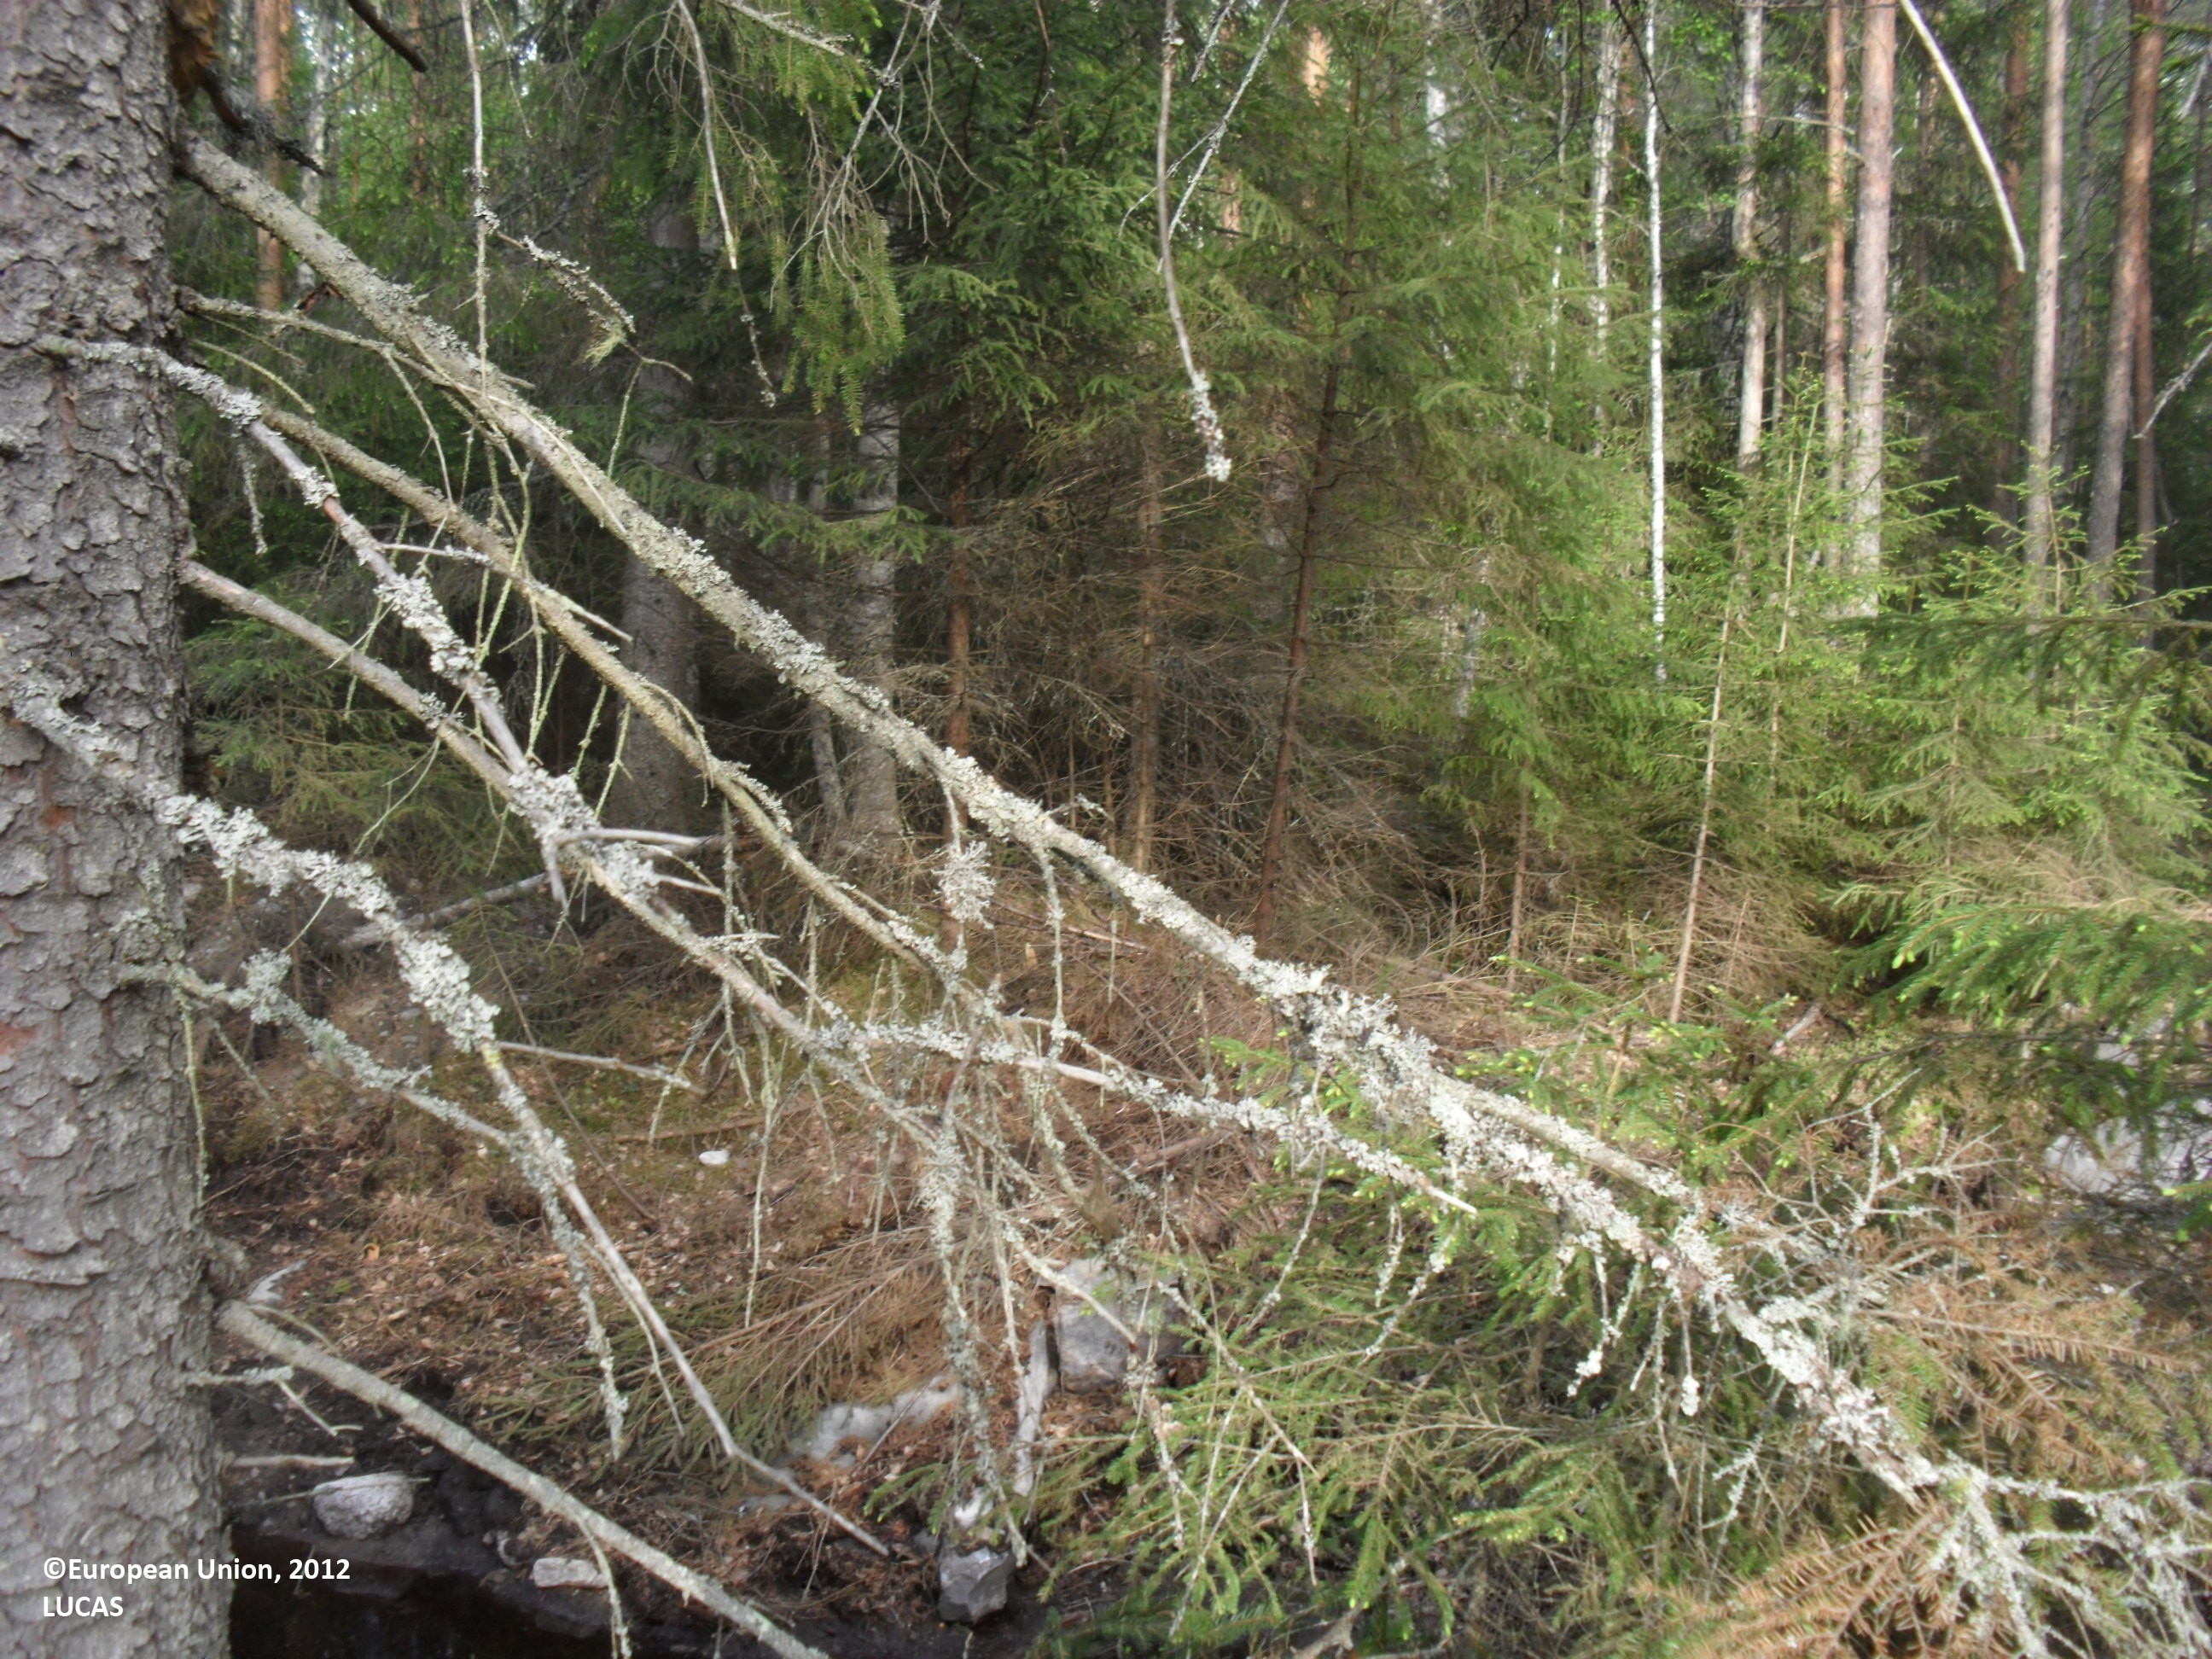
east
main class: Woodland
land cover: Other coniferous woodland
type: boreal forest
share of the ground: 25 - 50 %
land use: Forestry
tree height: > 5 m
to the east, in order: Other coniferous woodland; Other mixed woodland; Ditches and canals; Other mixed woodland; Ditches and canals; Other mixed woodland; Spruce dominated coniferous woodland; Ditches and canals; Spruce dominated coniferous woodland; Ditches and canals; Spruce dominated coniferous woodland; Tracks; Spruce dominated coniferous woodland; Other mixed woodland; Pine dominated mixed woodland; Other mixed woodland
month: June
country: FI
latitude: 62.8389
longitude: 23.3591
